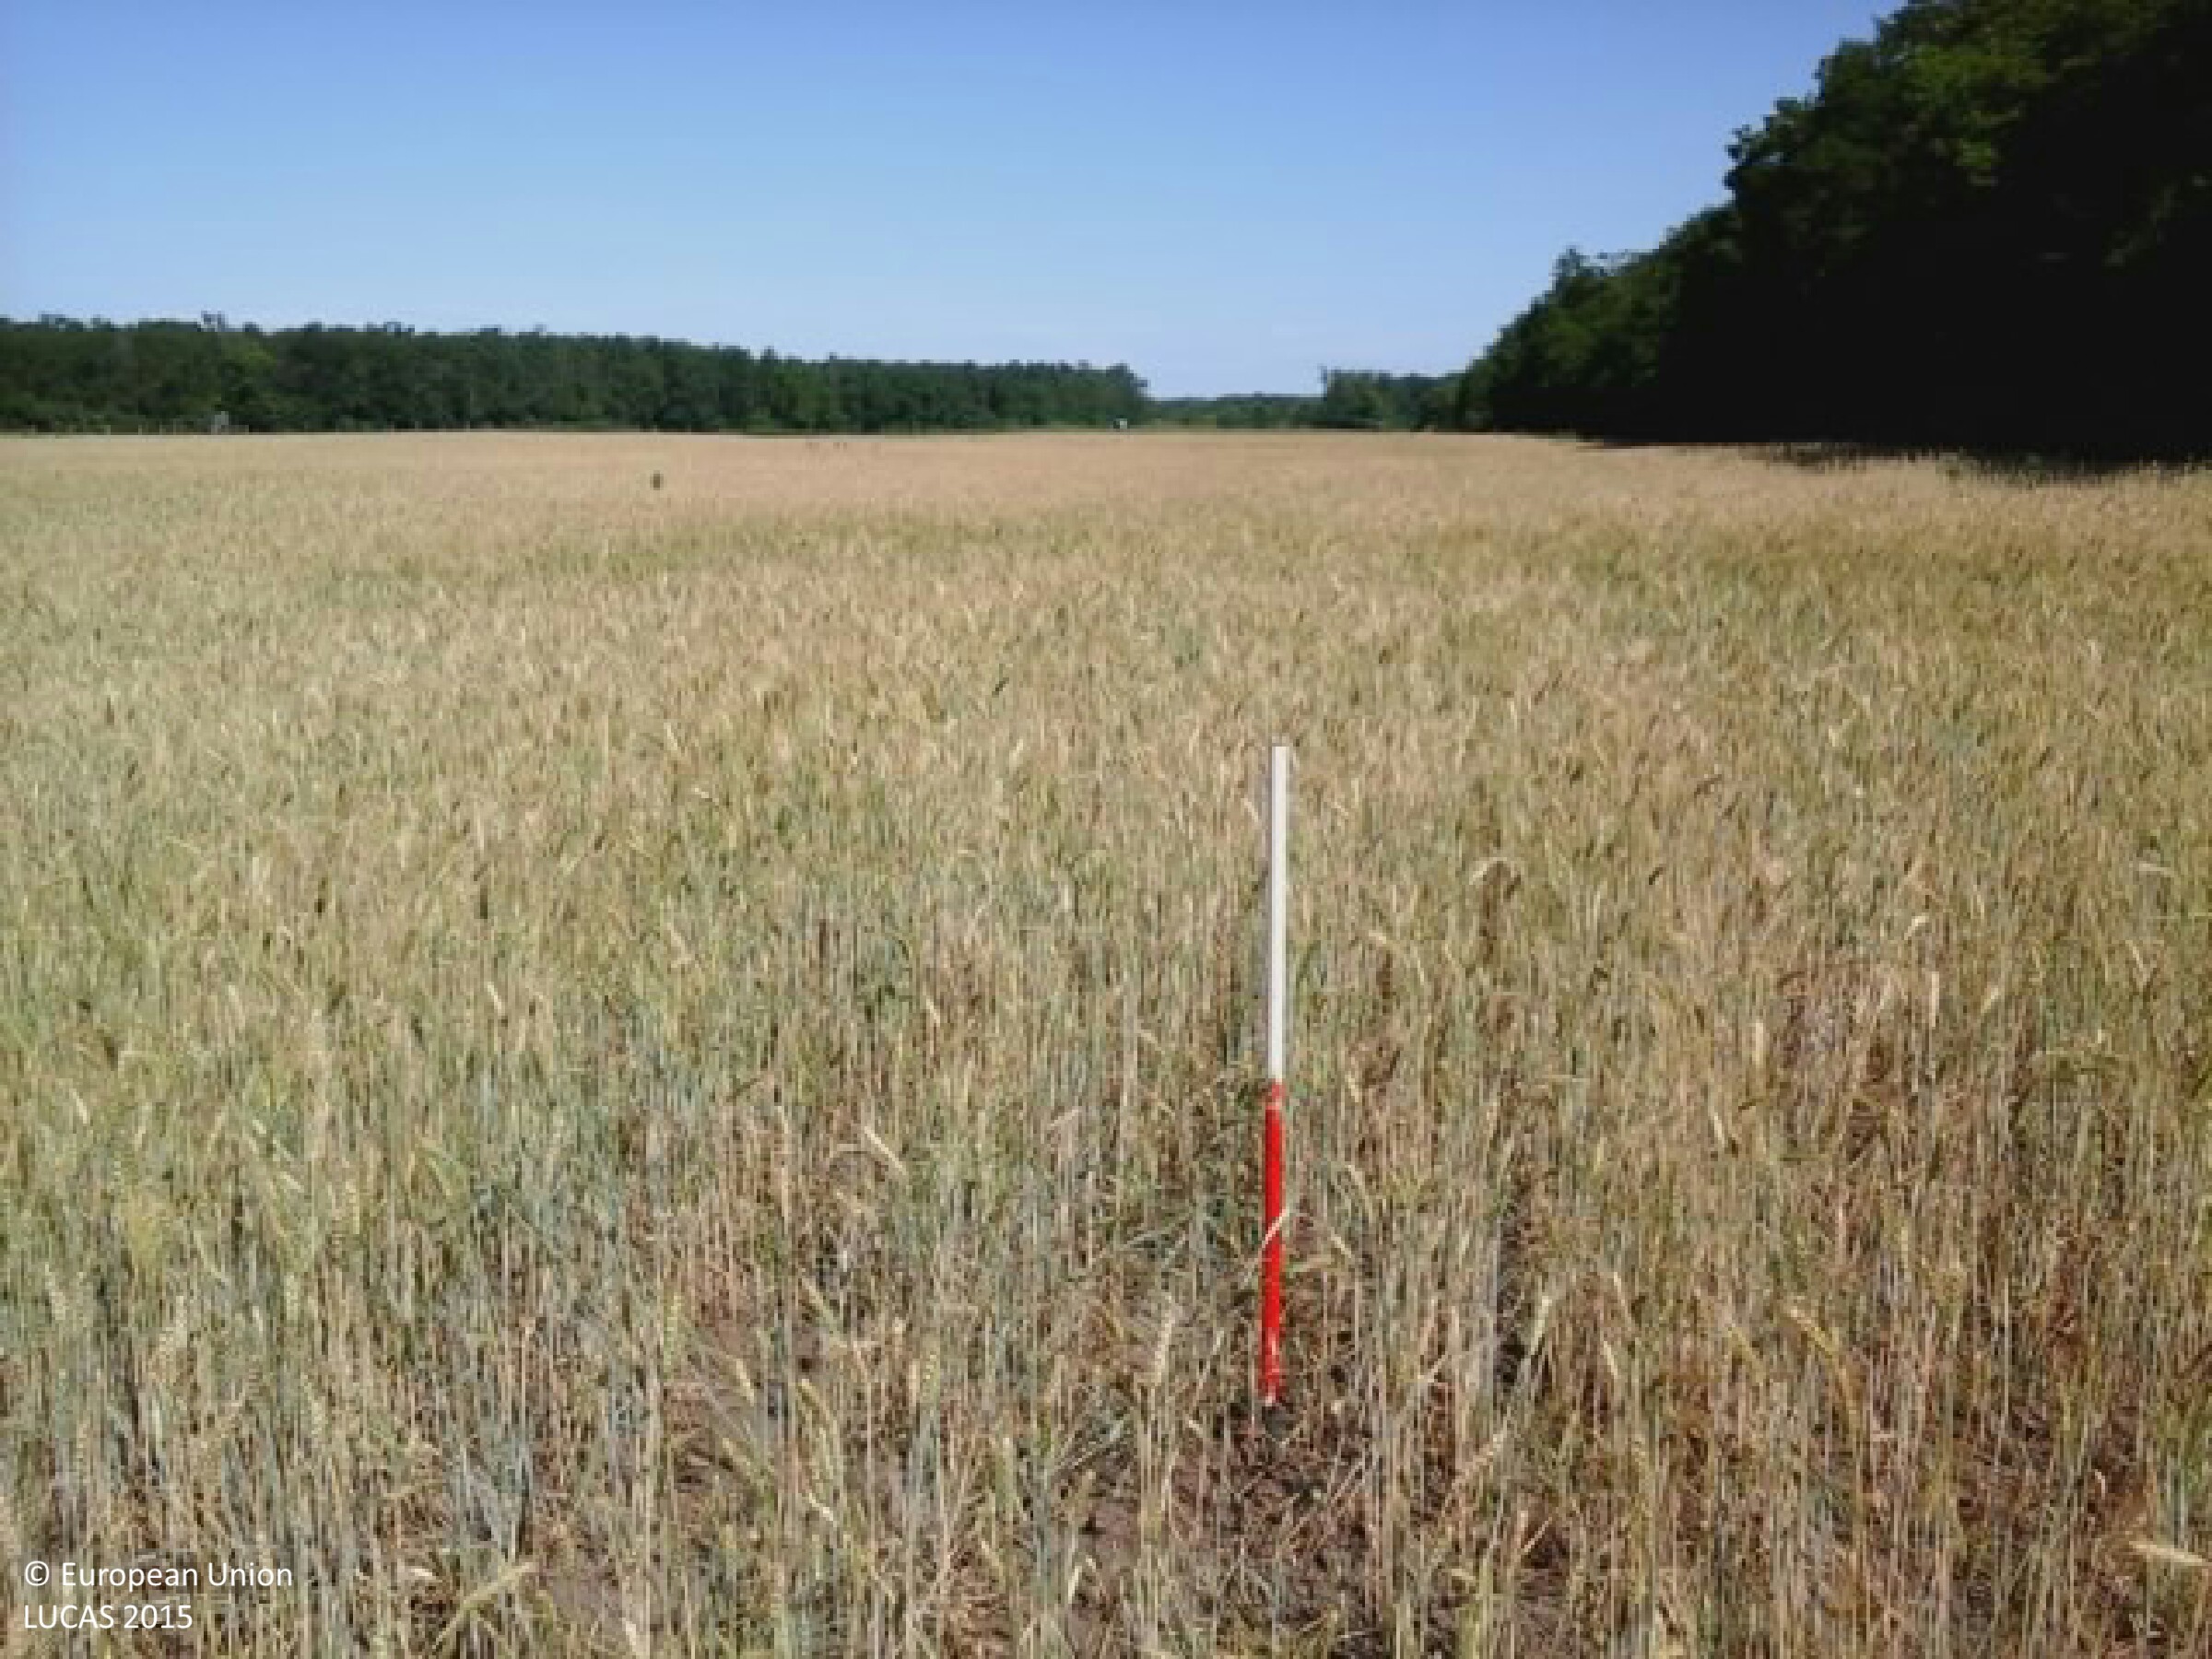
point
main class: Cropland
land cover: Common wheat
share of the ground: > 75 %
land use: Agriculture (excluding fallow land and kitchen gardens)
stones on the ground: < 10 %
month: June
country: HU
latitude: 46.3525
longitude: 19.2021
